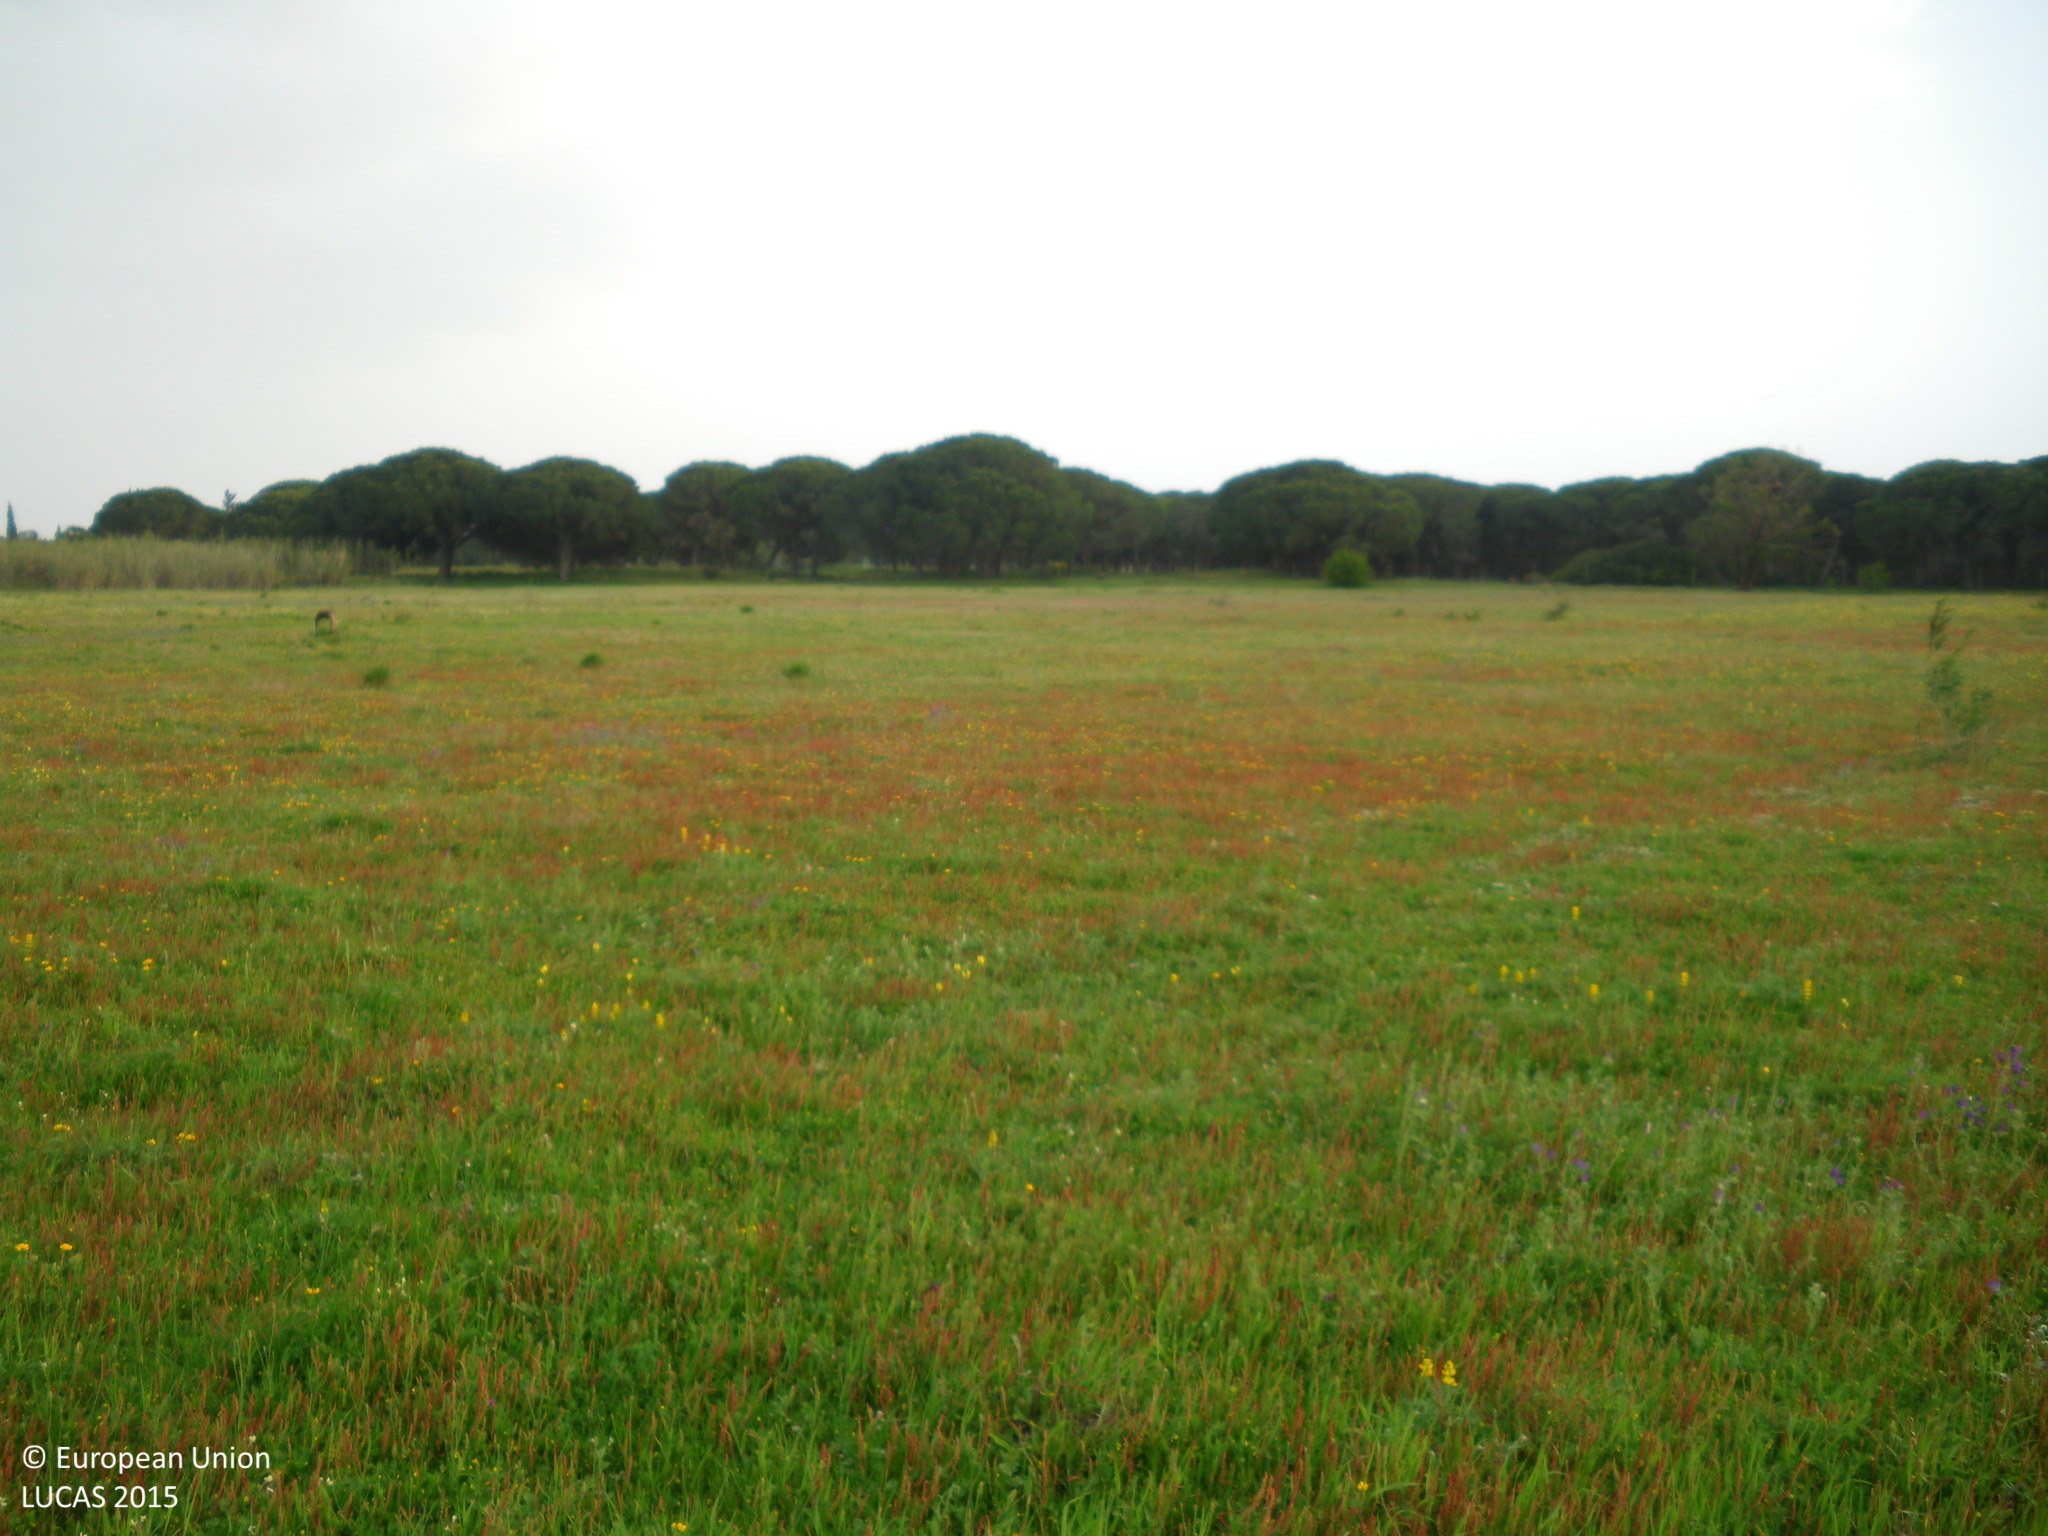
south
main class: Grassland
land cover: Spontaneously vegetated surfaces
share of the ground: > 75 %
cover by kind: herbaceous plants 100 %
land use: Fallow land
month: April
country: ES
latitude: 36.4707
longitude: -6.1342
